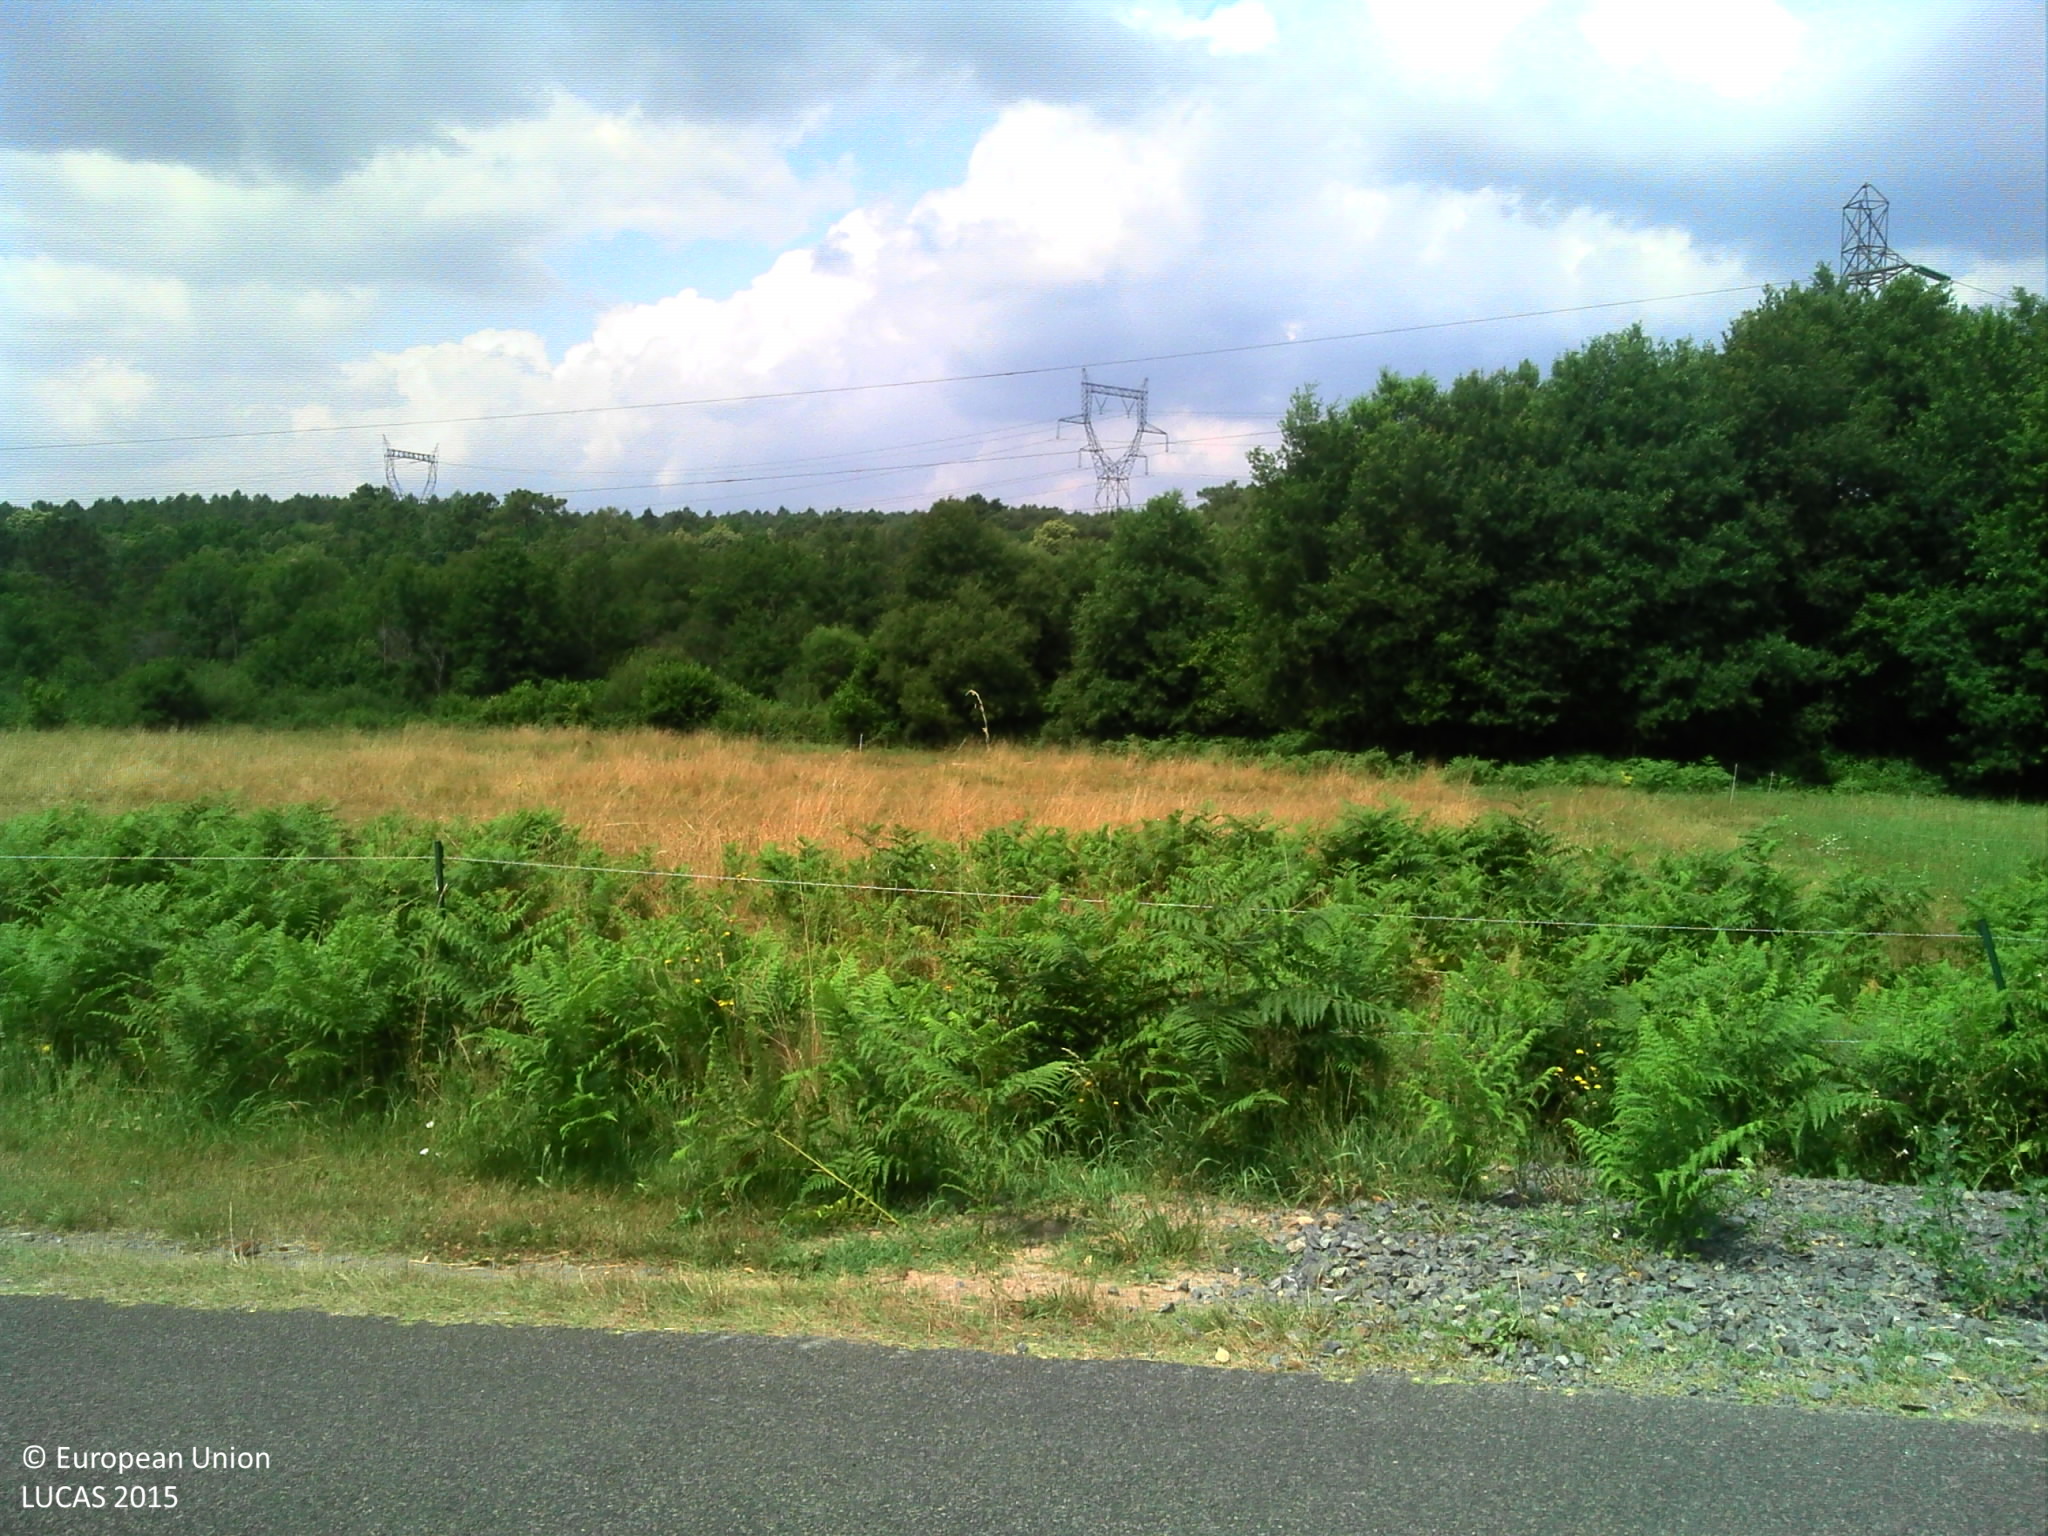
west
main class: Grassland
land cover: Grassland without tree/shrub cover
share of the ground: > 75 %
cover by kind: herbaceous plants 100 %
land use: Agriculture (excluding fallow land and kitchen gardens)
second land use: Residential
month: July
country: FR
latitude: 47.3253
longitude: 0.1184
